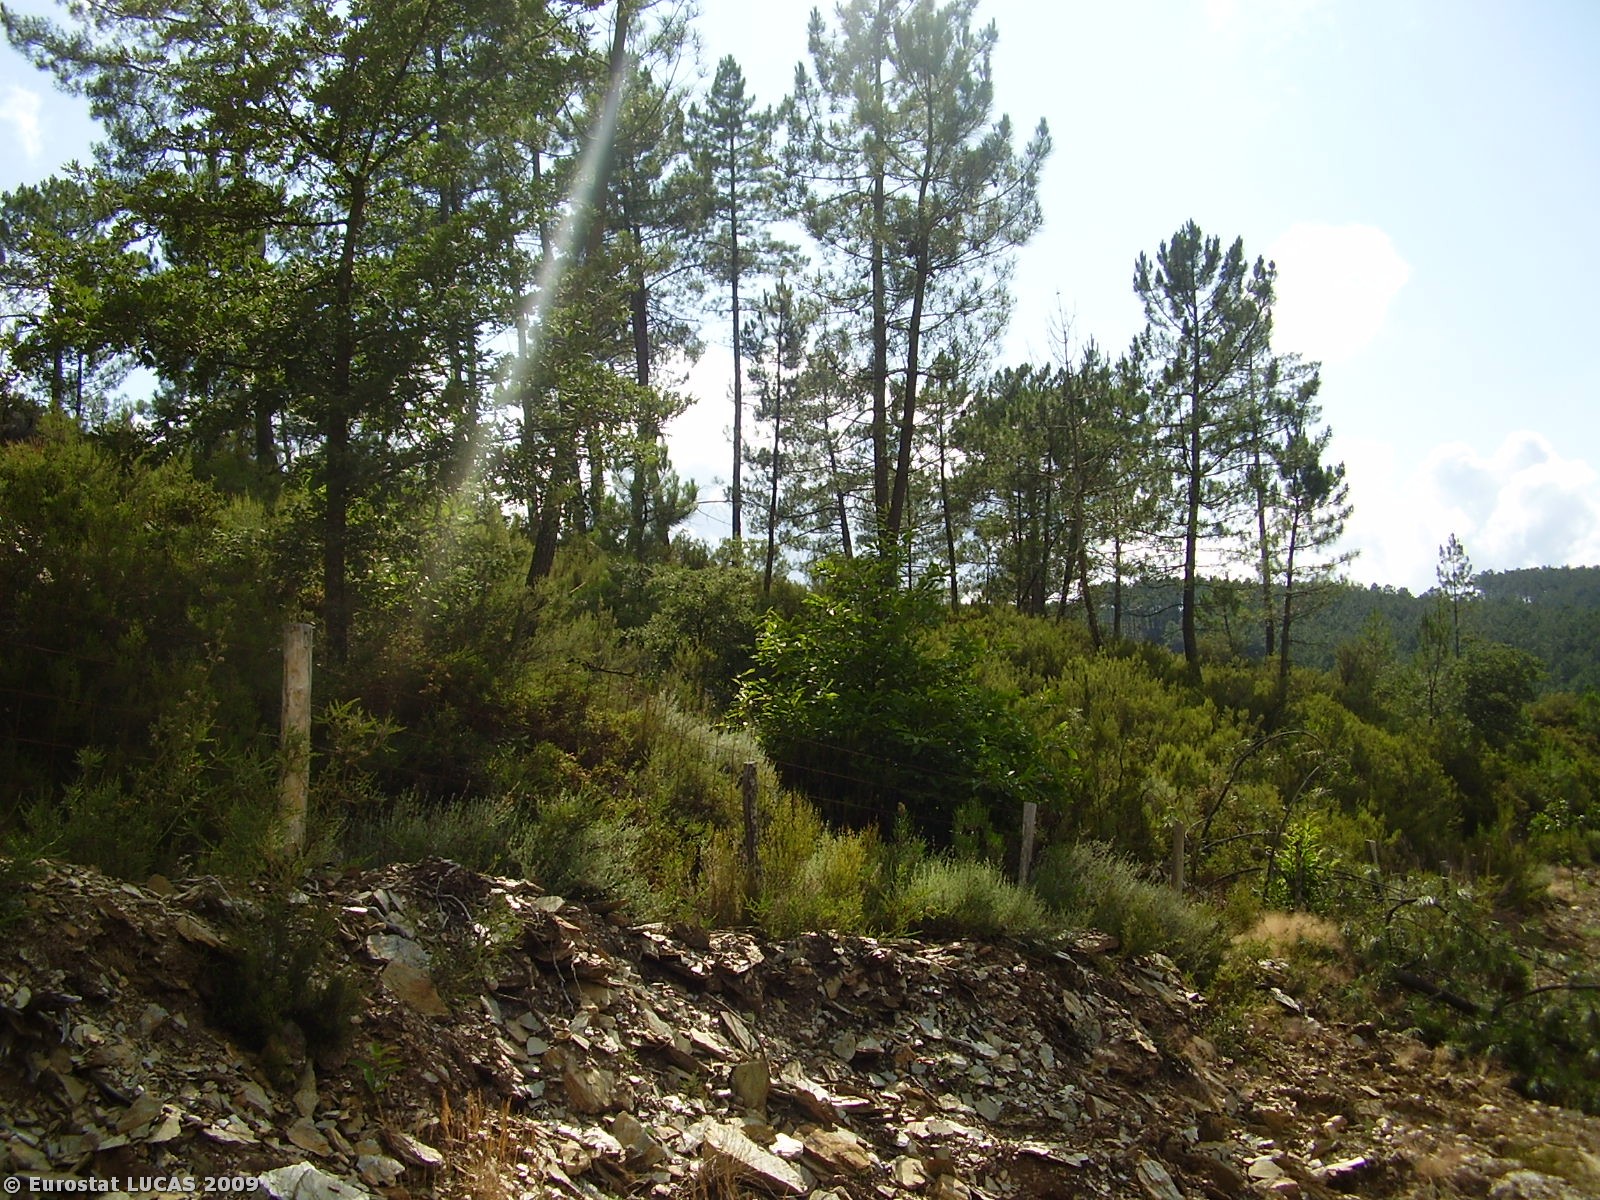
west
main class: Cropland
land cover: Nuts trees
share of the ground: < 10 %
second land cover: Bare land
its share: < 10 %
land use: Agriculture (excluding fallow land and kitchen gardens)
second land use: Unused
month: July
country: PT
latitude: 41.4935
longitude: -7.5570
